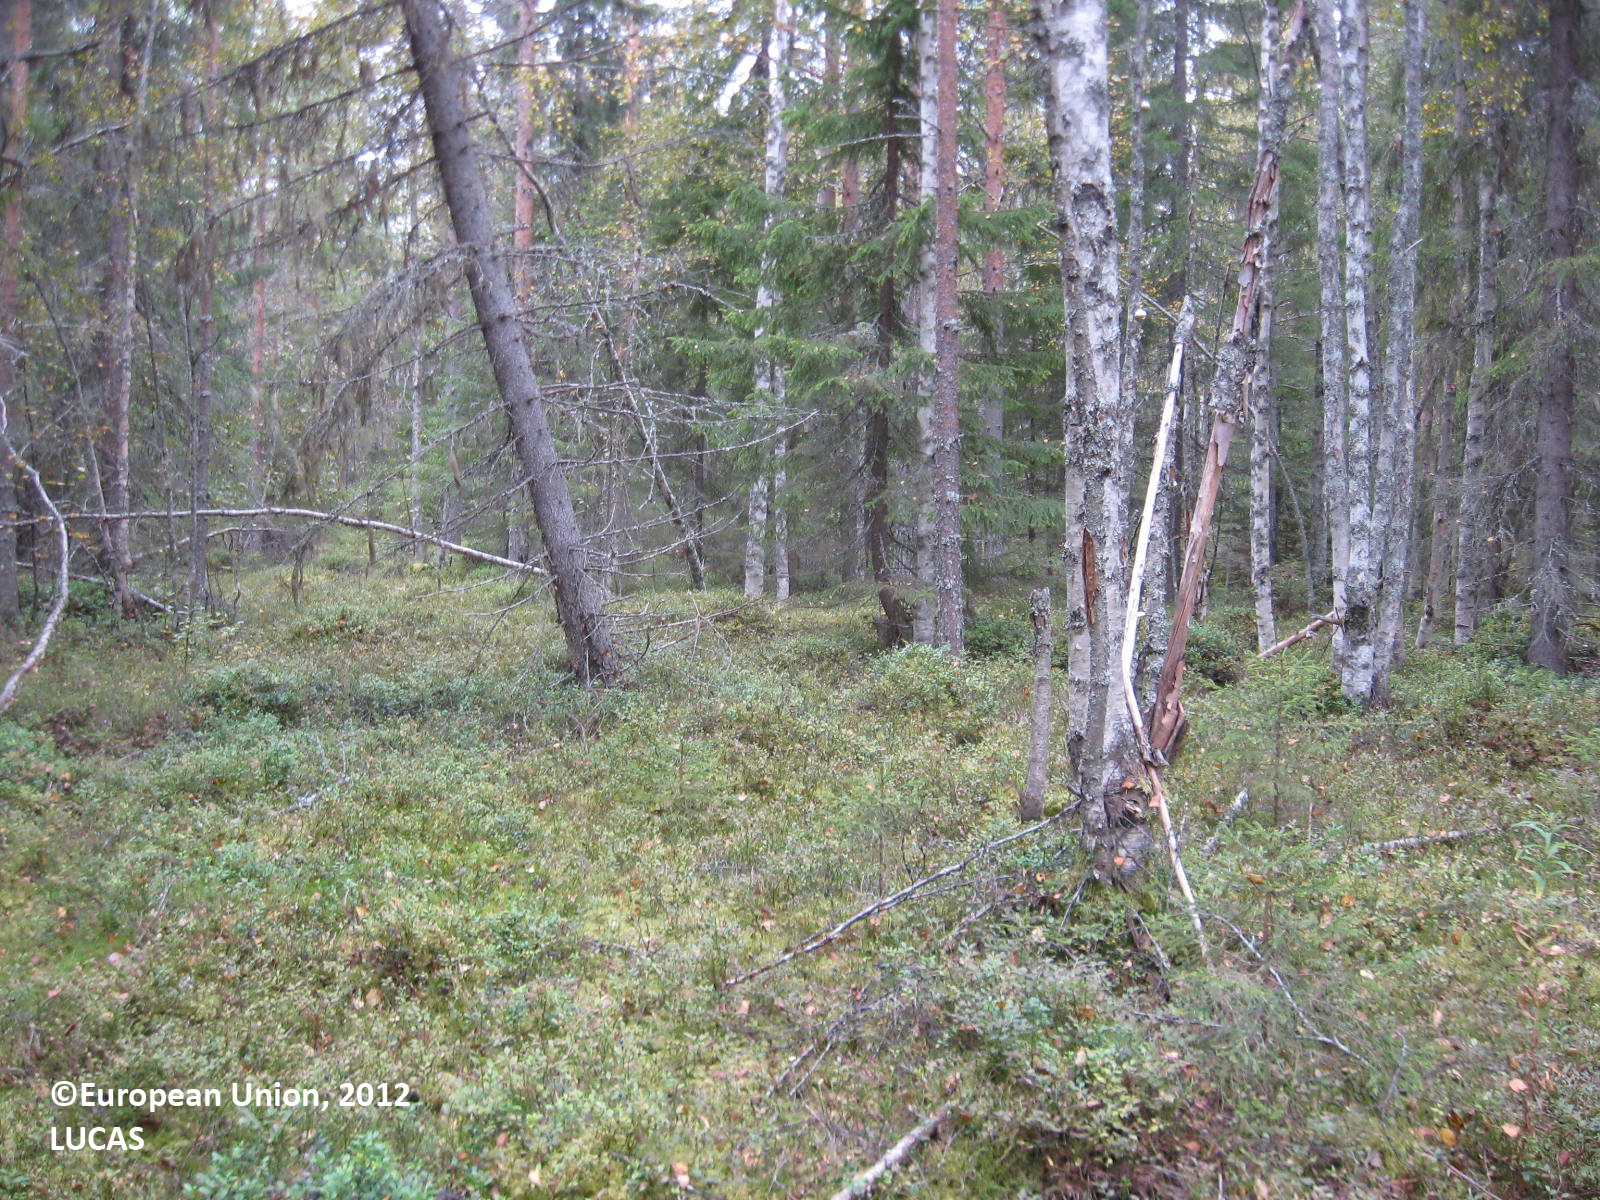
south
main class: Woodland
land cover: Spruce dominated mixed woodland
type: boreal forest
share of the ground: > 75 %
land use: Forestry
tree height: > 5 m
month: August
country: FI
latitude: 63.9313
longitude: 29.2405
